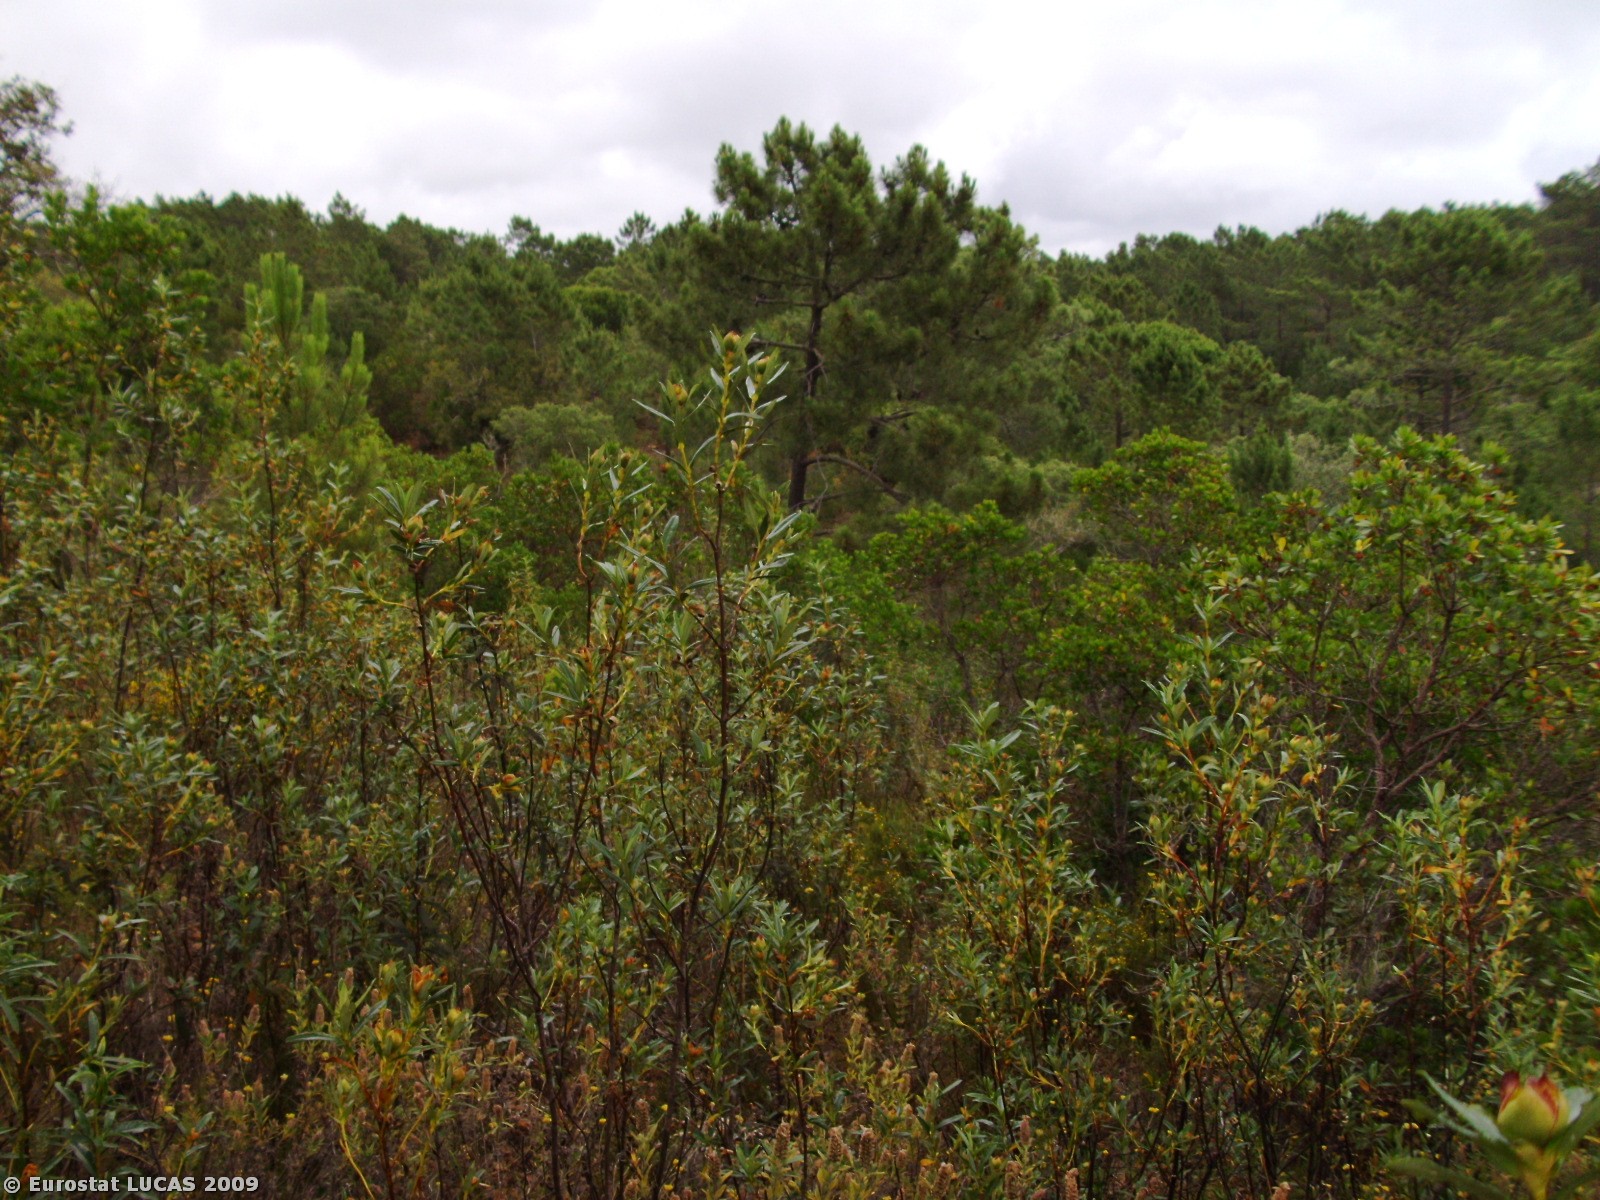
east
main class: Woodland
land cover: Coniferous woodland
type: coniferous forest of the mediterranean region
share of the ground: 10 - 25 %
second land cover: Shrubland with sparse tree cover
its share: 50 - 75 %
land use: Forestry
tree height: > 5 m
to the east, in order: Coniferous woodland; Shrubland with sparse tree cover; Coniferous woodland; Tracks; Coniferous woodland; Spontaneously vegetated surfaces
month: June
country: PT
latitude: 37.1829
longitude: -8.8336
